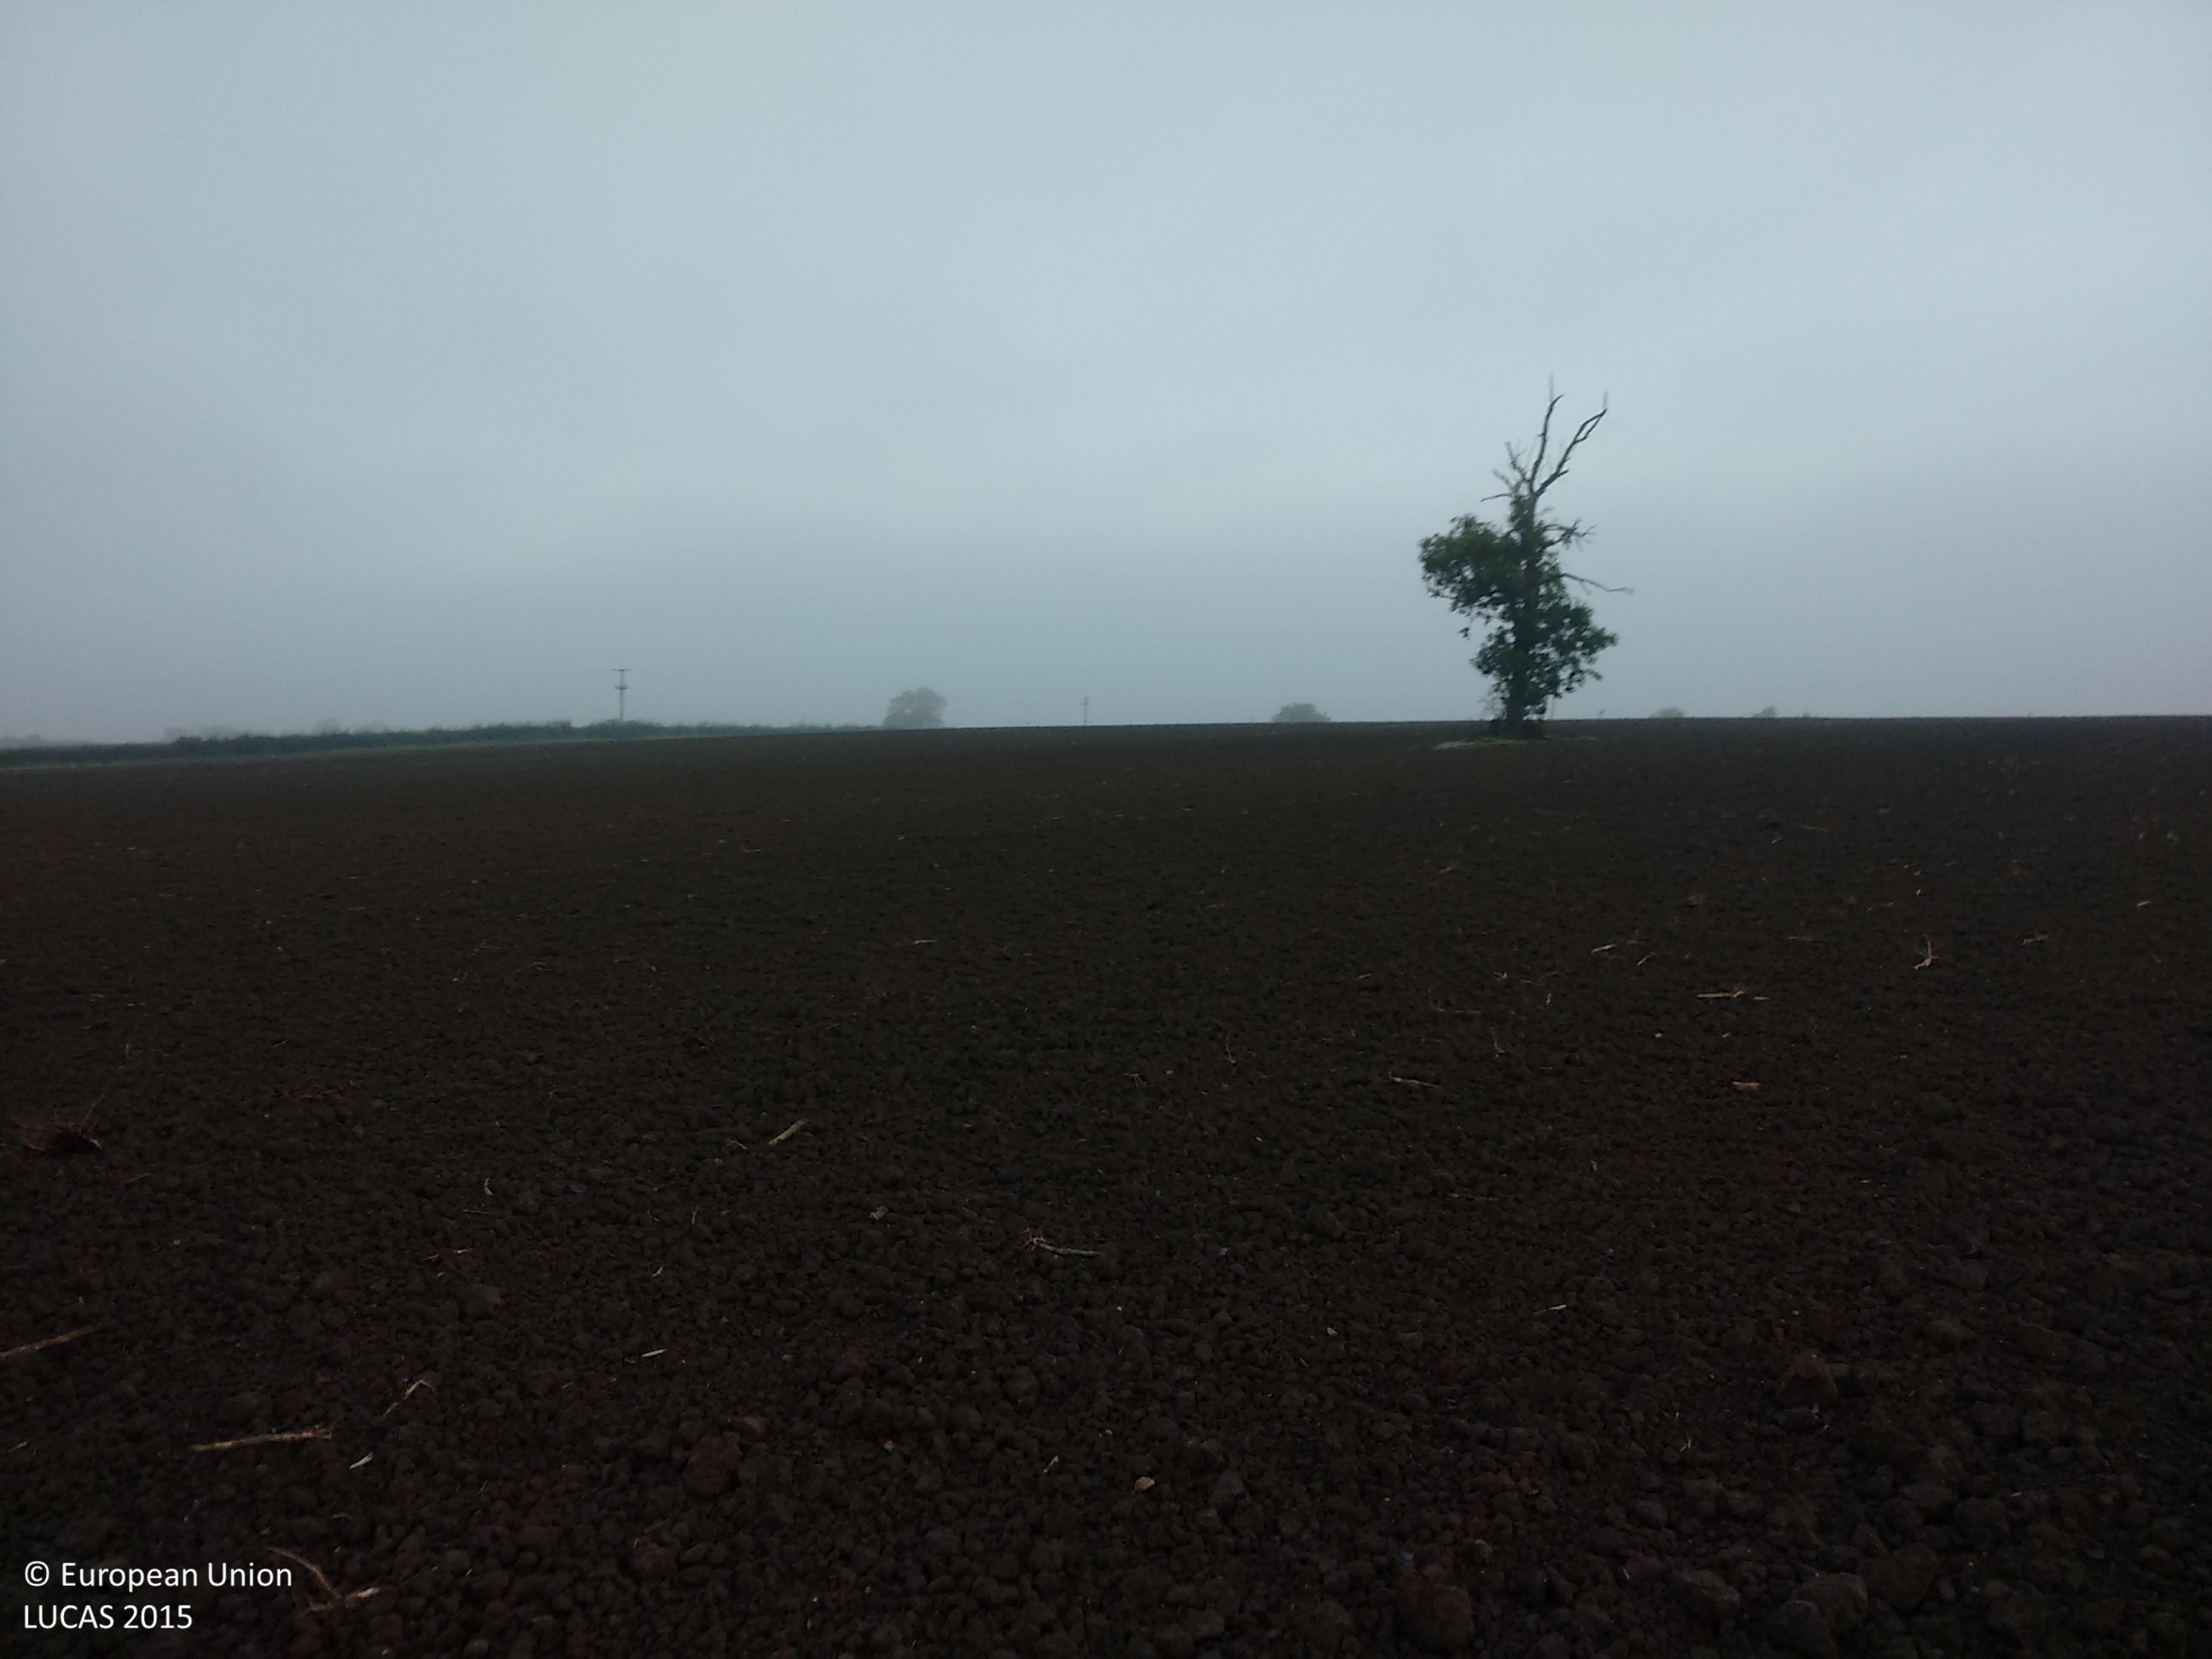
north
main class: Cropland
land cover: Common wheat
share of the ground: > 75 %
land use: Agriculture (excluding fallow land and kitchen gardens)
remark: Harvested field
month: October
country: GB
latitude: 51.7289
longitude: -2.3562
